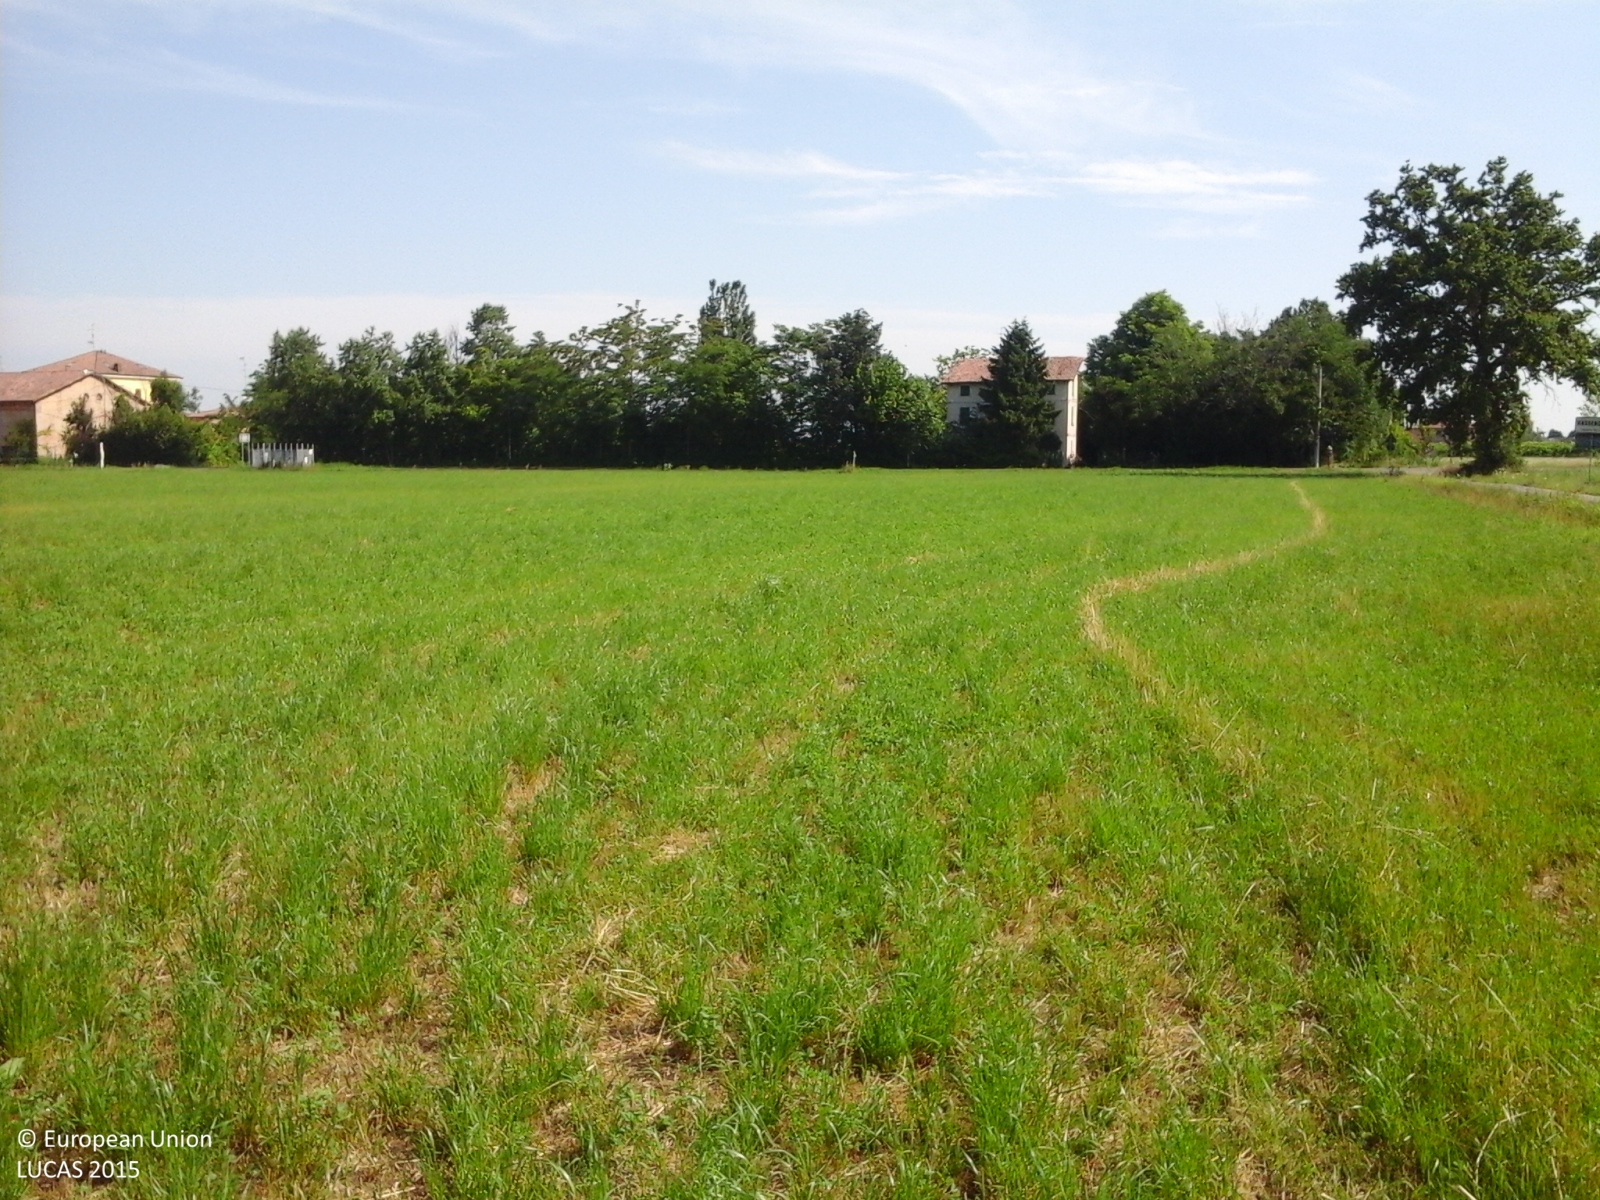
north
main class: Grassland
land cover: Spontaneously vegetated surfaces
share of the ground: > 75 %
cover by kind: herbaceous plants 100 %
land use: Agriculture (excluding fallow land and kitchen gardens)
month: June
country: IT
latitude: 44.7270
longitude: 10.6930
